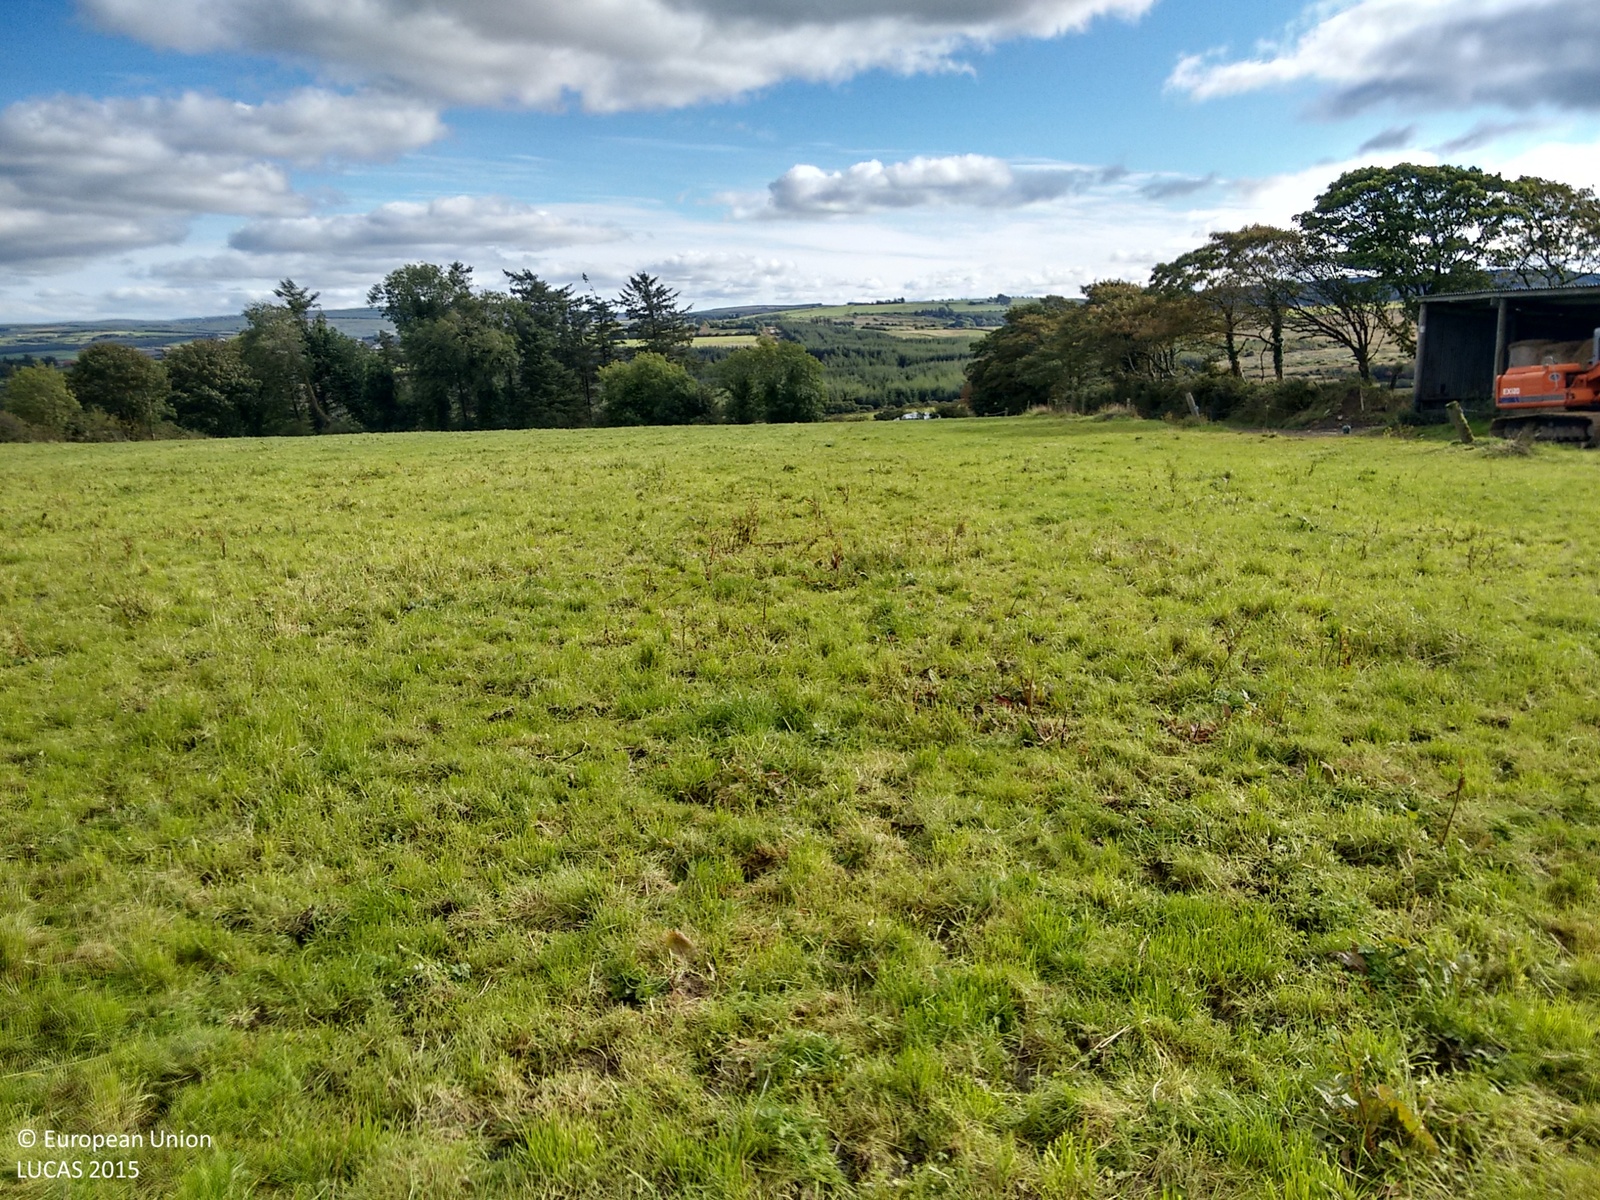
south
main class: Grassland
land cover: Grassland without tree/shrub cover
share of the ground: > 75 %
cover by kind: herbaceous plants 85 %, unconsolidated bare surface 10 %, shrubs 5 %
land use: Agriculture (excluding fallow land and kitchen gardens)
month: September
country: IE
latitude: 52.3272
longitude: -9.4072
